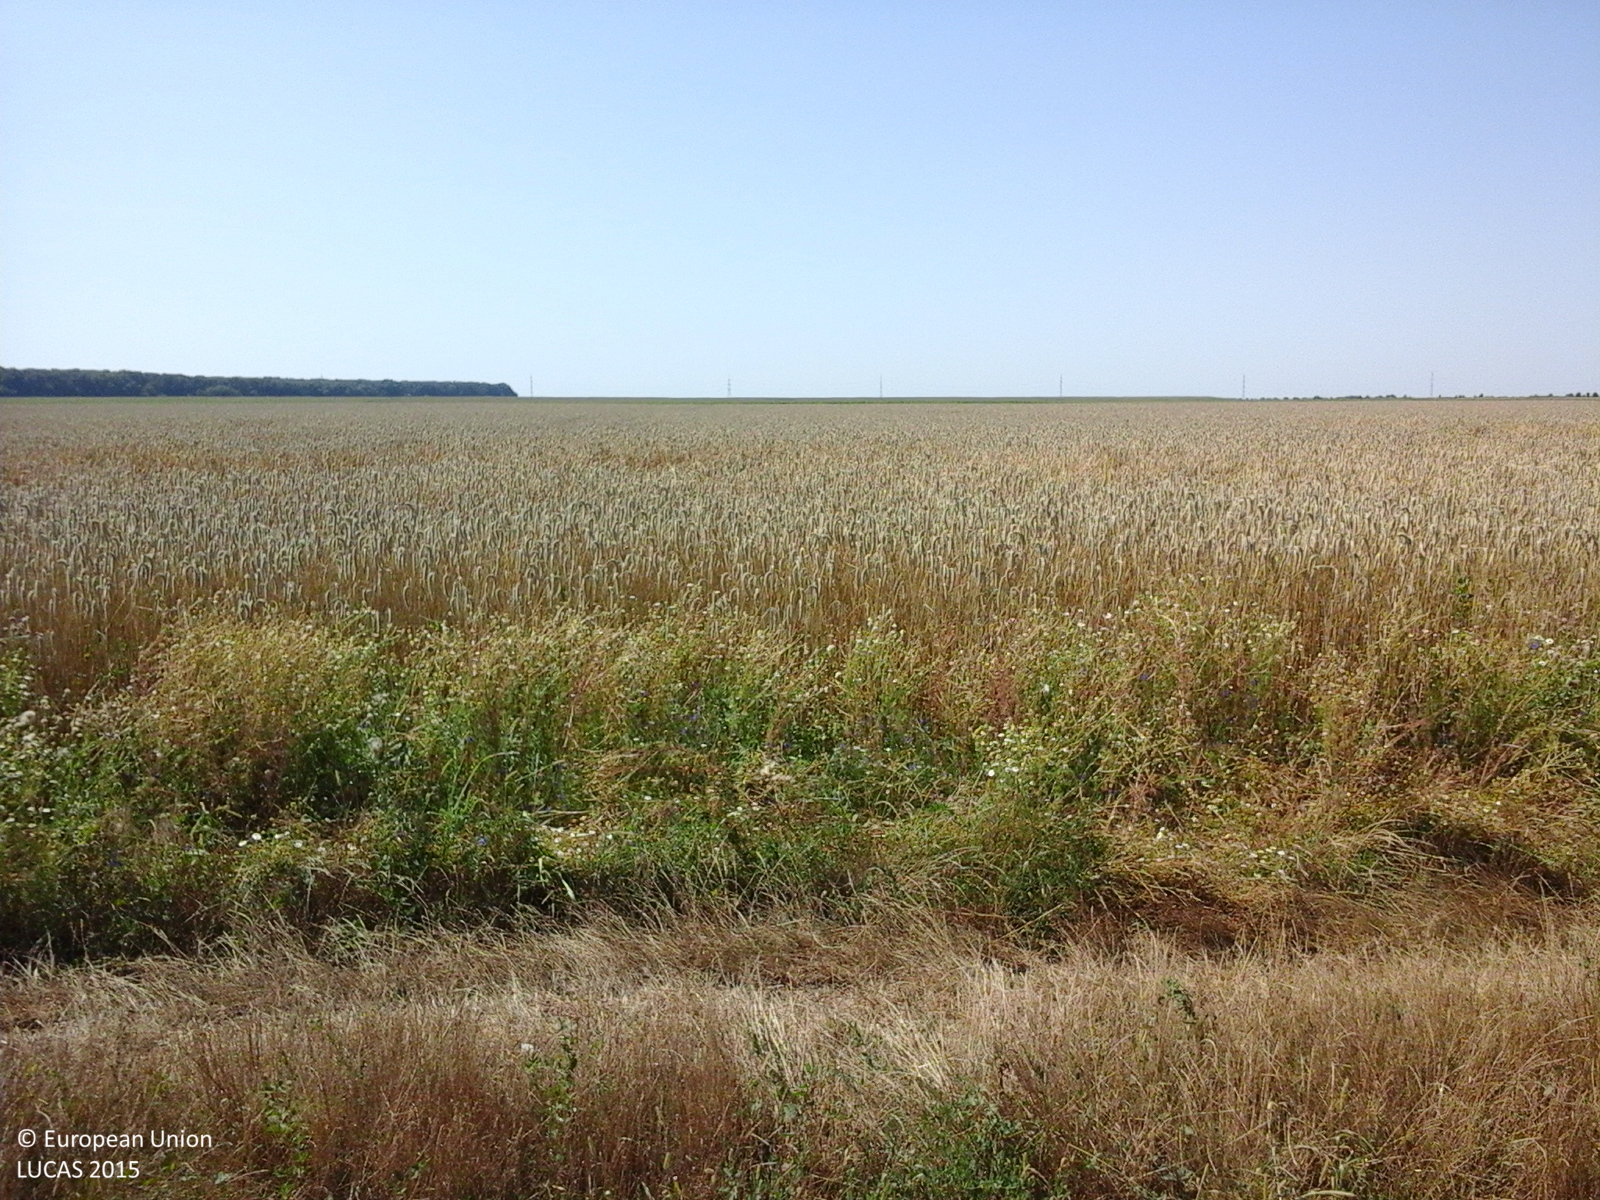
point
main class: Cropland
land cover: Common wheat
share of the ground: > 75 %
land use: Agriculture (excluding fallow land and kitchen gardens)
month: July
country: RO
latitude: 44.4187
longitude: 26.4794
